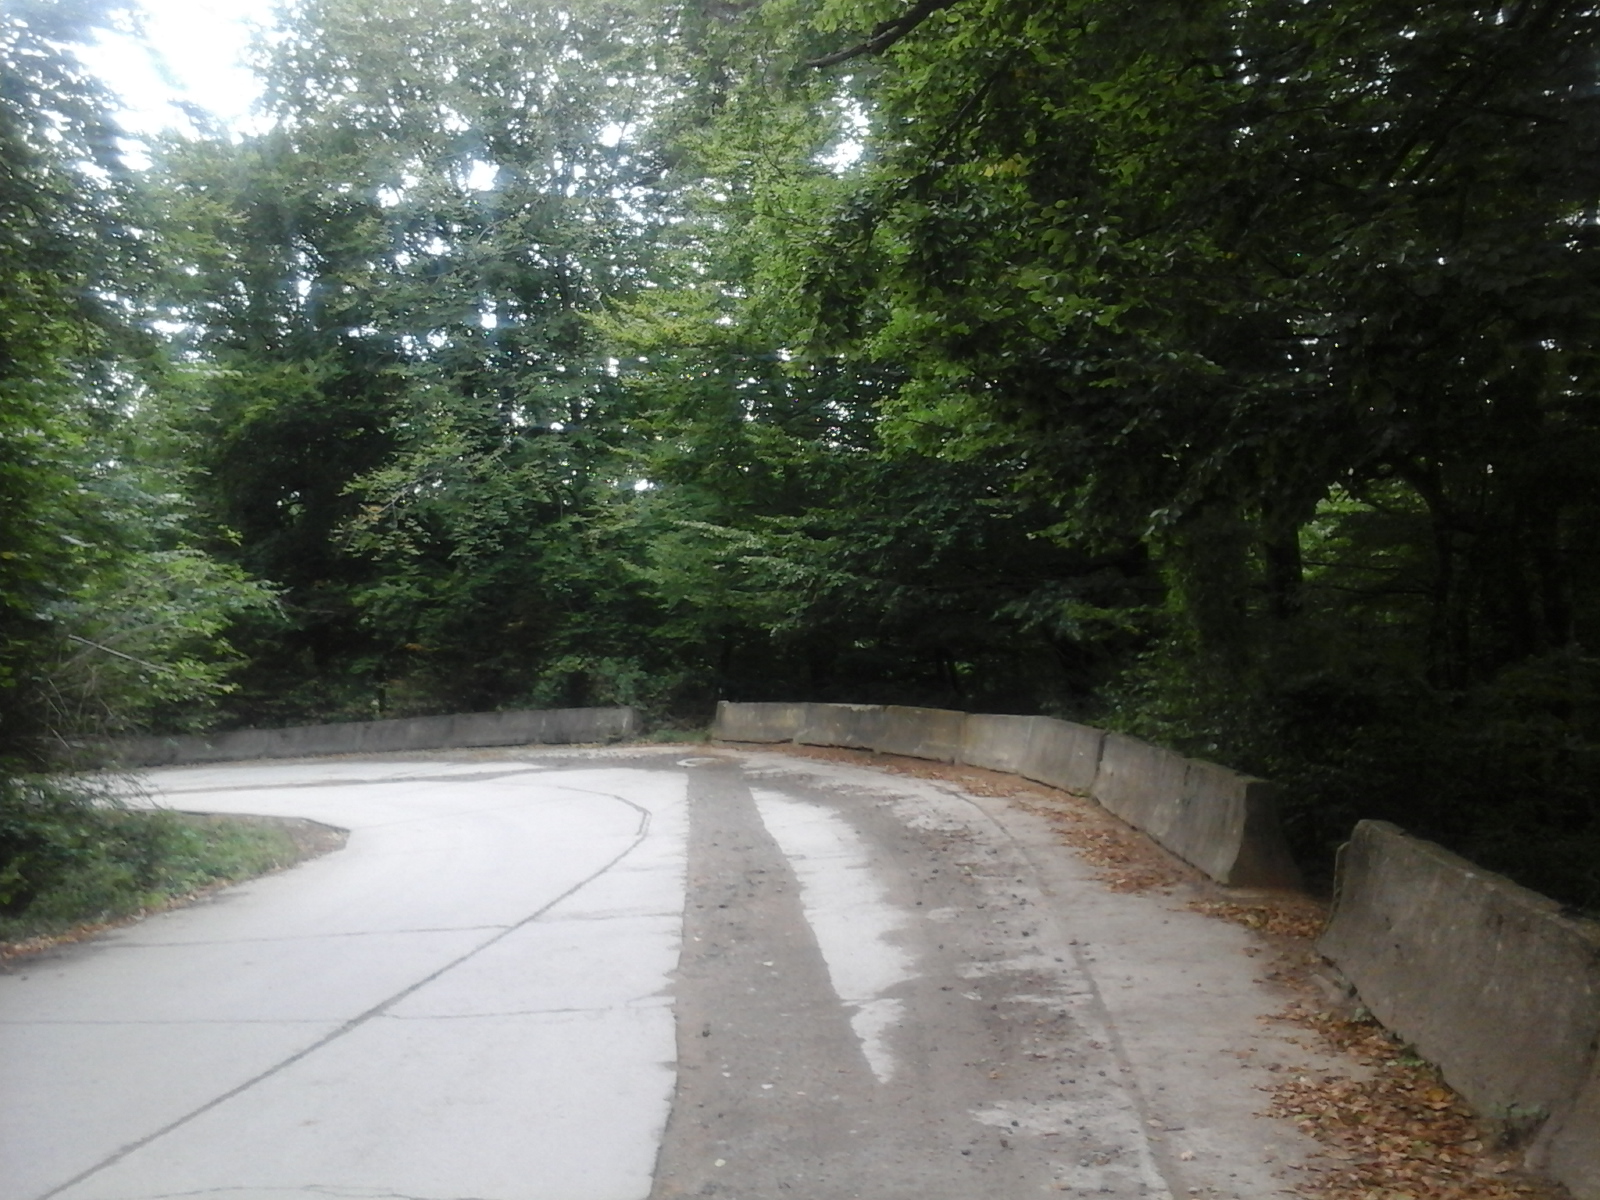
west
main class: Woodland
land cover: Broadleaved woodland
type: beech forest
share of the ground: > 75 %
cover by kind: broadleaved forest trees 100 %
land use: Forestry
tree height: > 5 m
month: August
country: RO
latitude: 45.1056
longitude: 21.8666
